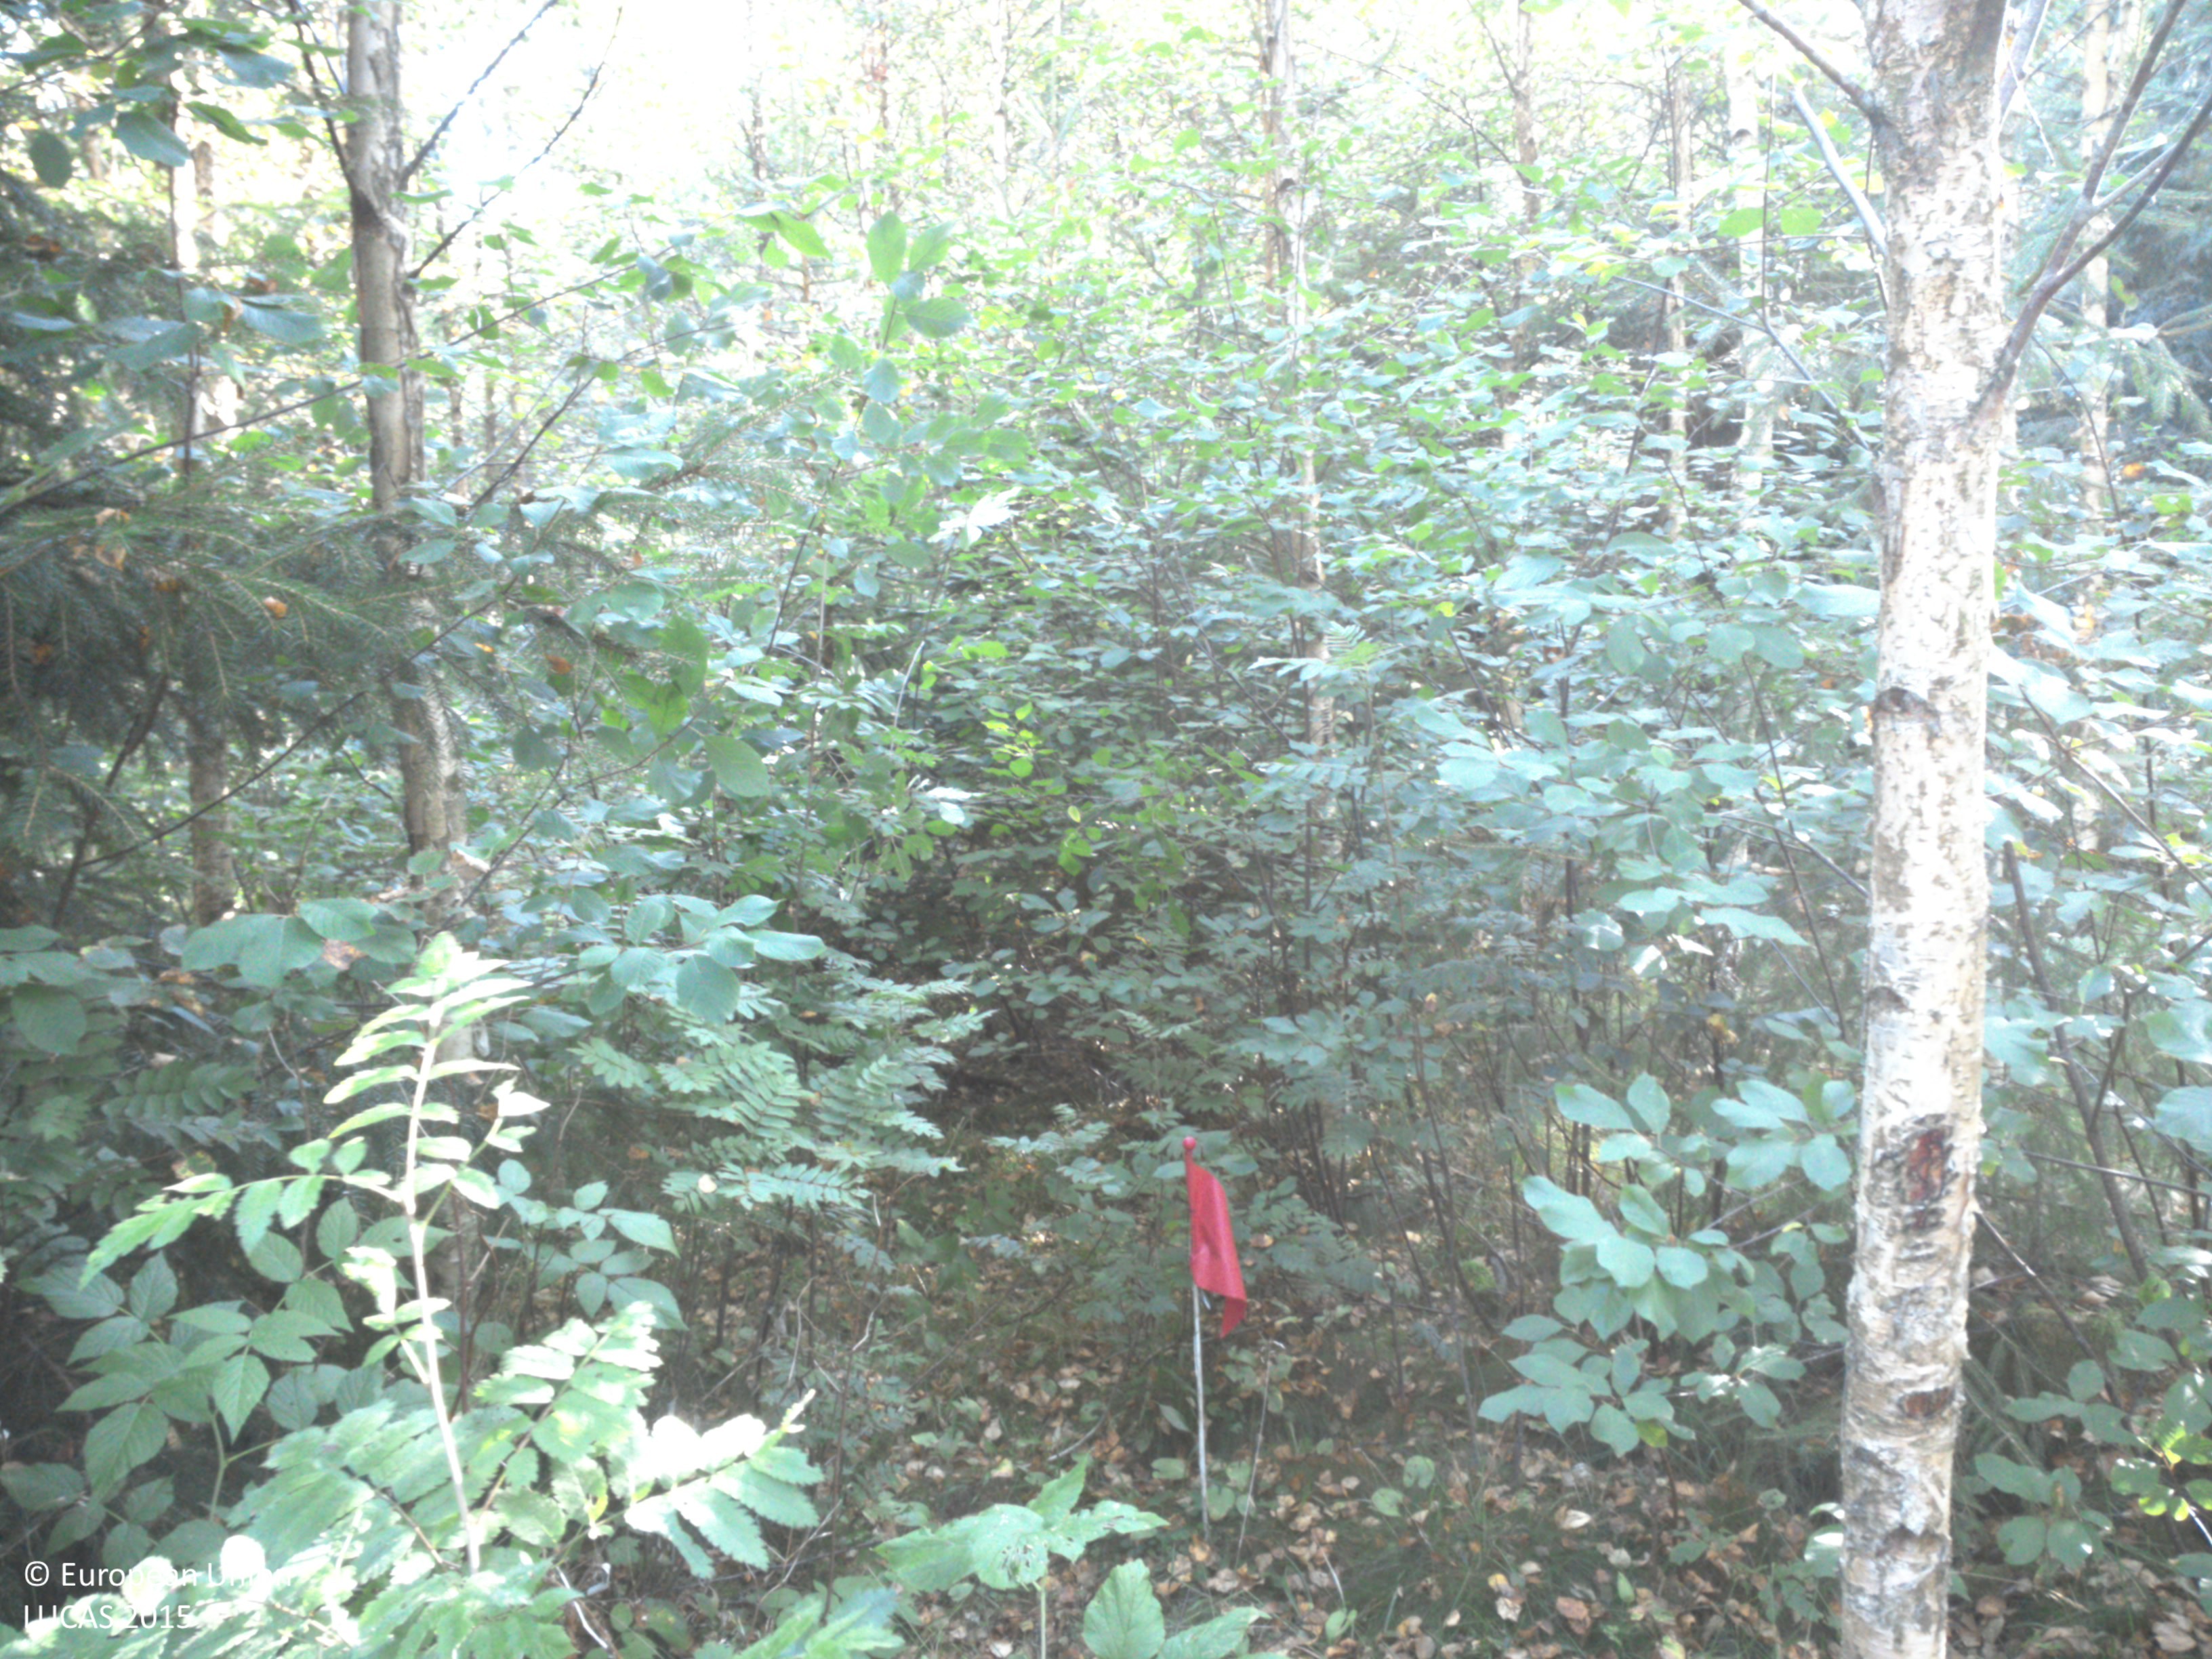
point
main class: Woodland
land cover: Broadleaved woodland
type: hemiboreal forest and nemoral coniferous forest and mixed broadleaved-coniferous forest
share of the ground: > 75 %
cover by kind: broadleaved forest trees 75 %, herbaceous plants 20 %, lichens and mosses 5 %
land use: Forestry
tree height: > 5 m
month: August
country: SE
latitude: 58.5774
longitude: 12.3168
